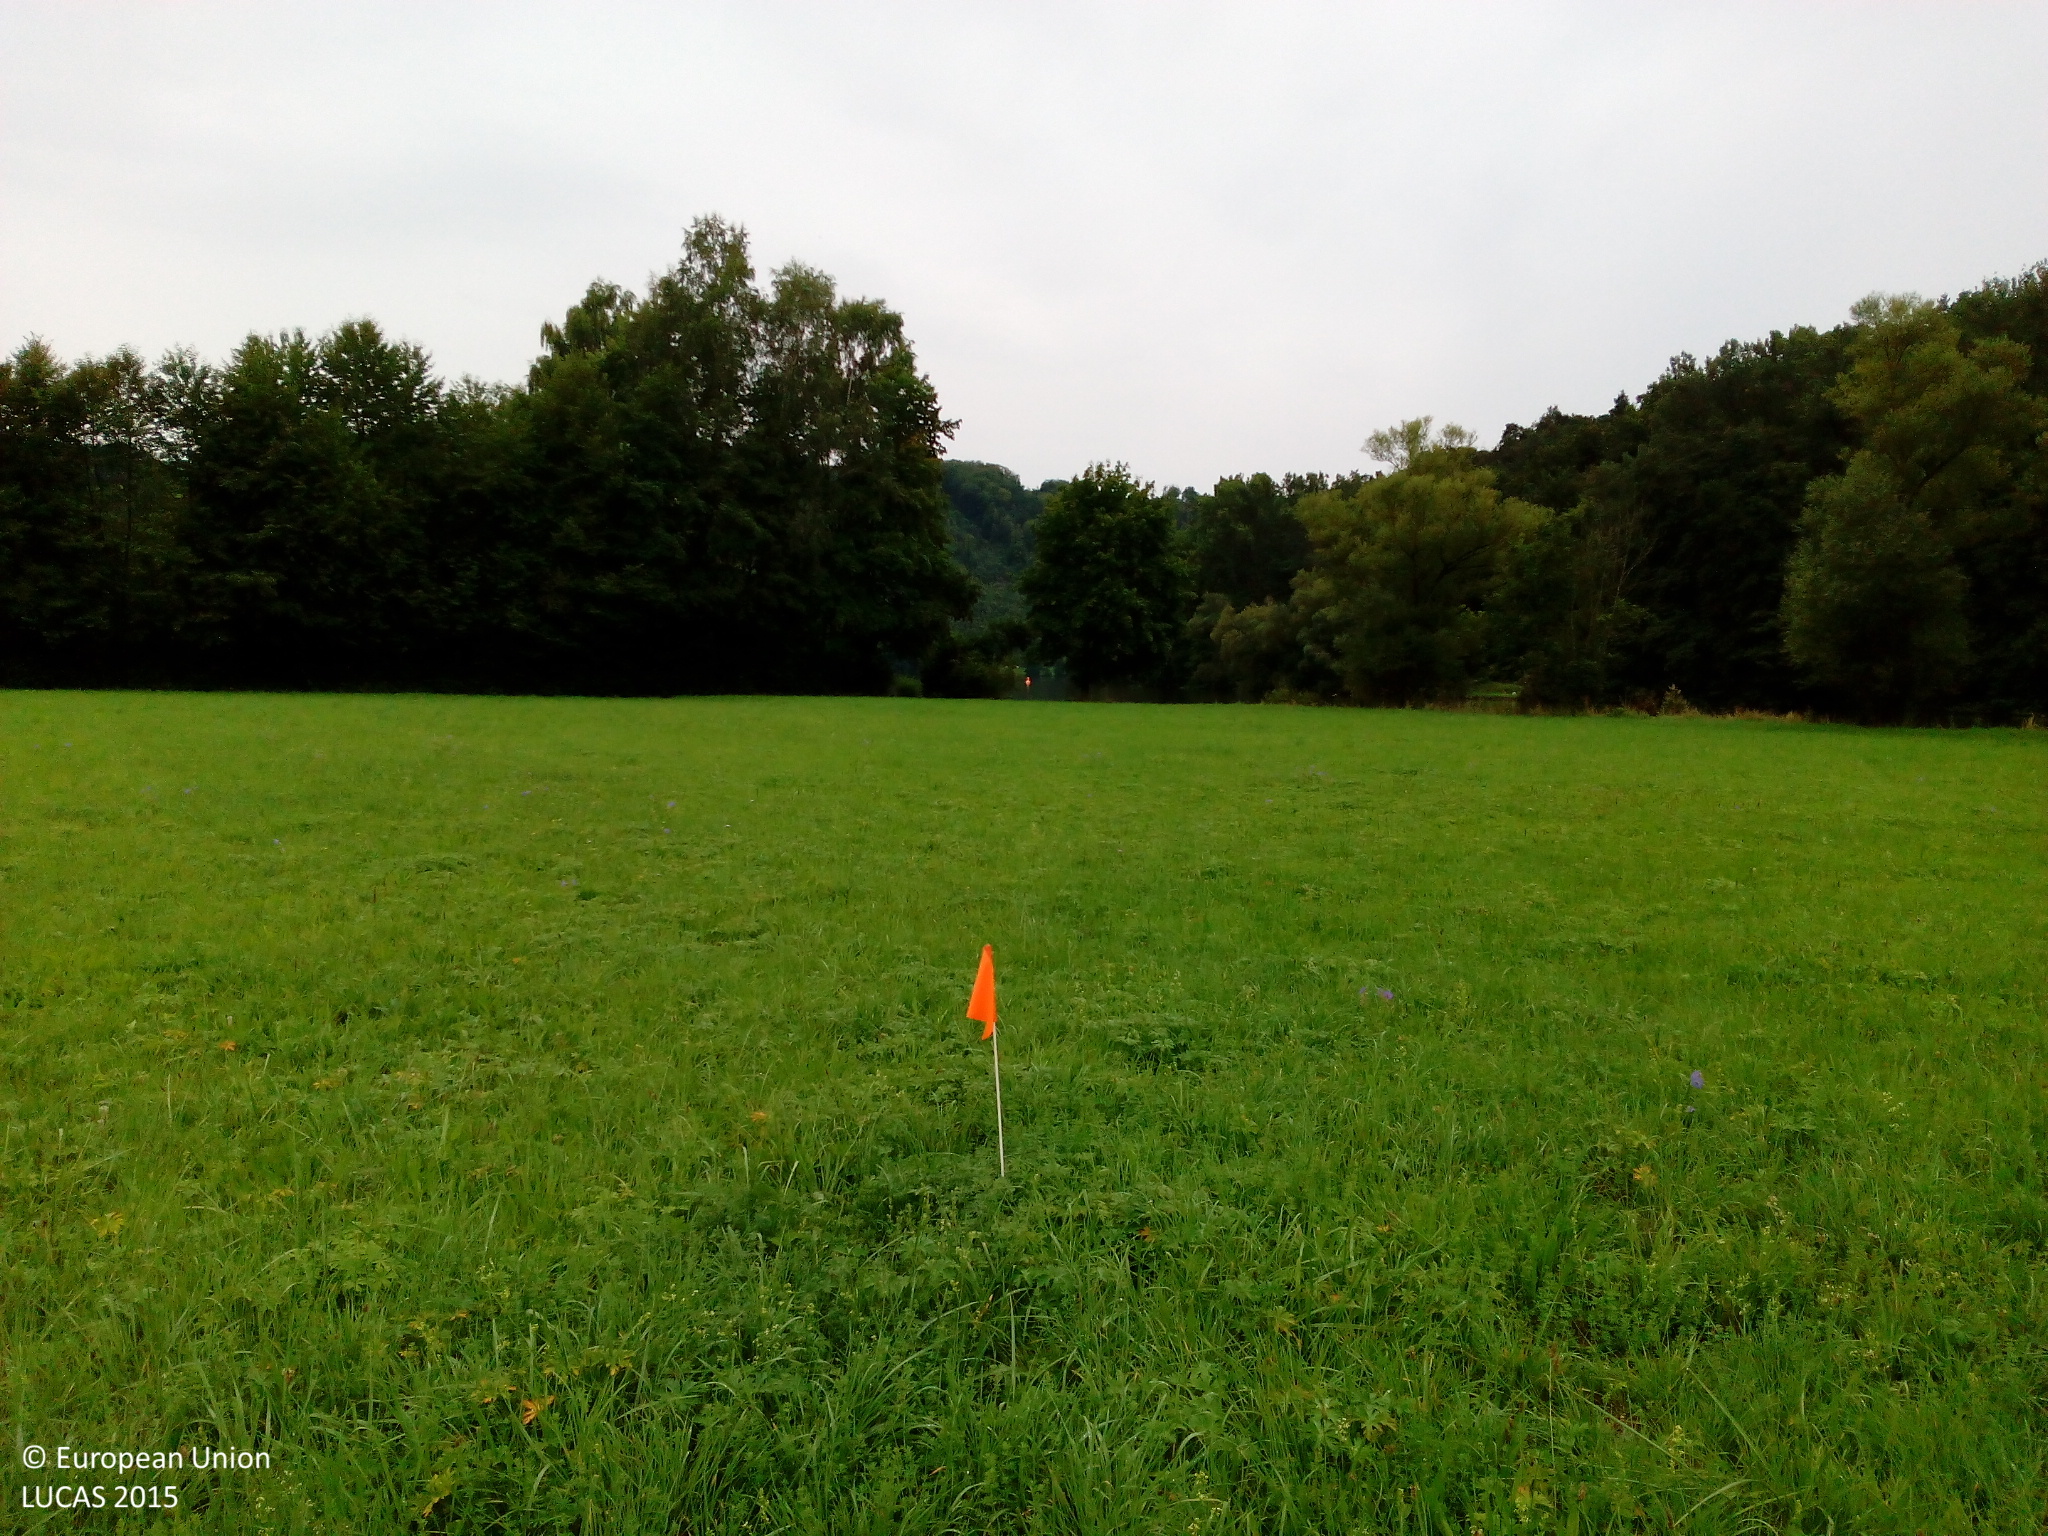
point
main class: Grassland
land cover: Grassland without tree/shrub cover
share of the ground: > 75 %
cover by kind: herbaceous plants 100 %
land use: Agriculture (excluding fallow land and kitchen gardens)
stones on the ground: < 10 %
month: September
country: DE
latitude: 49.7518
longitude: 9.5699
